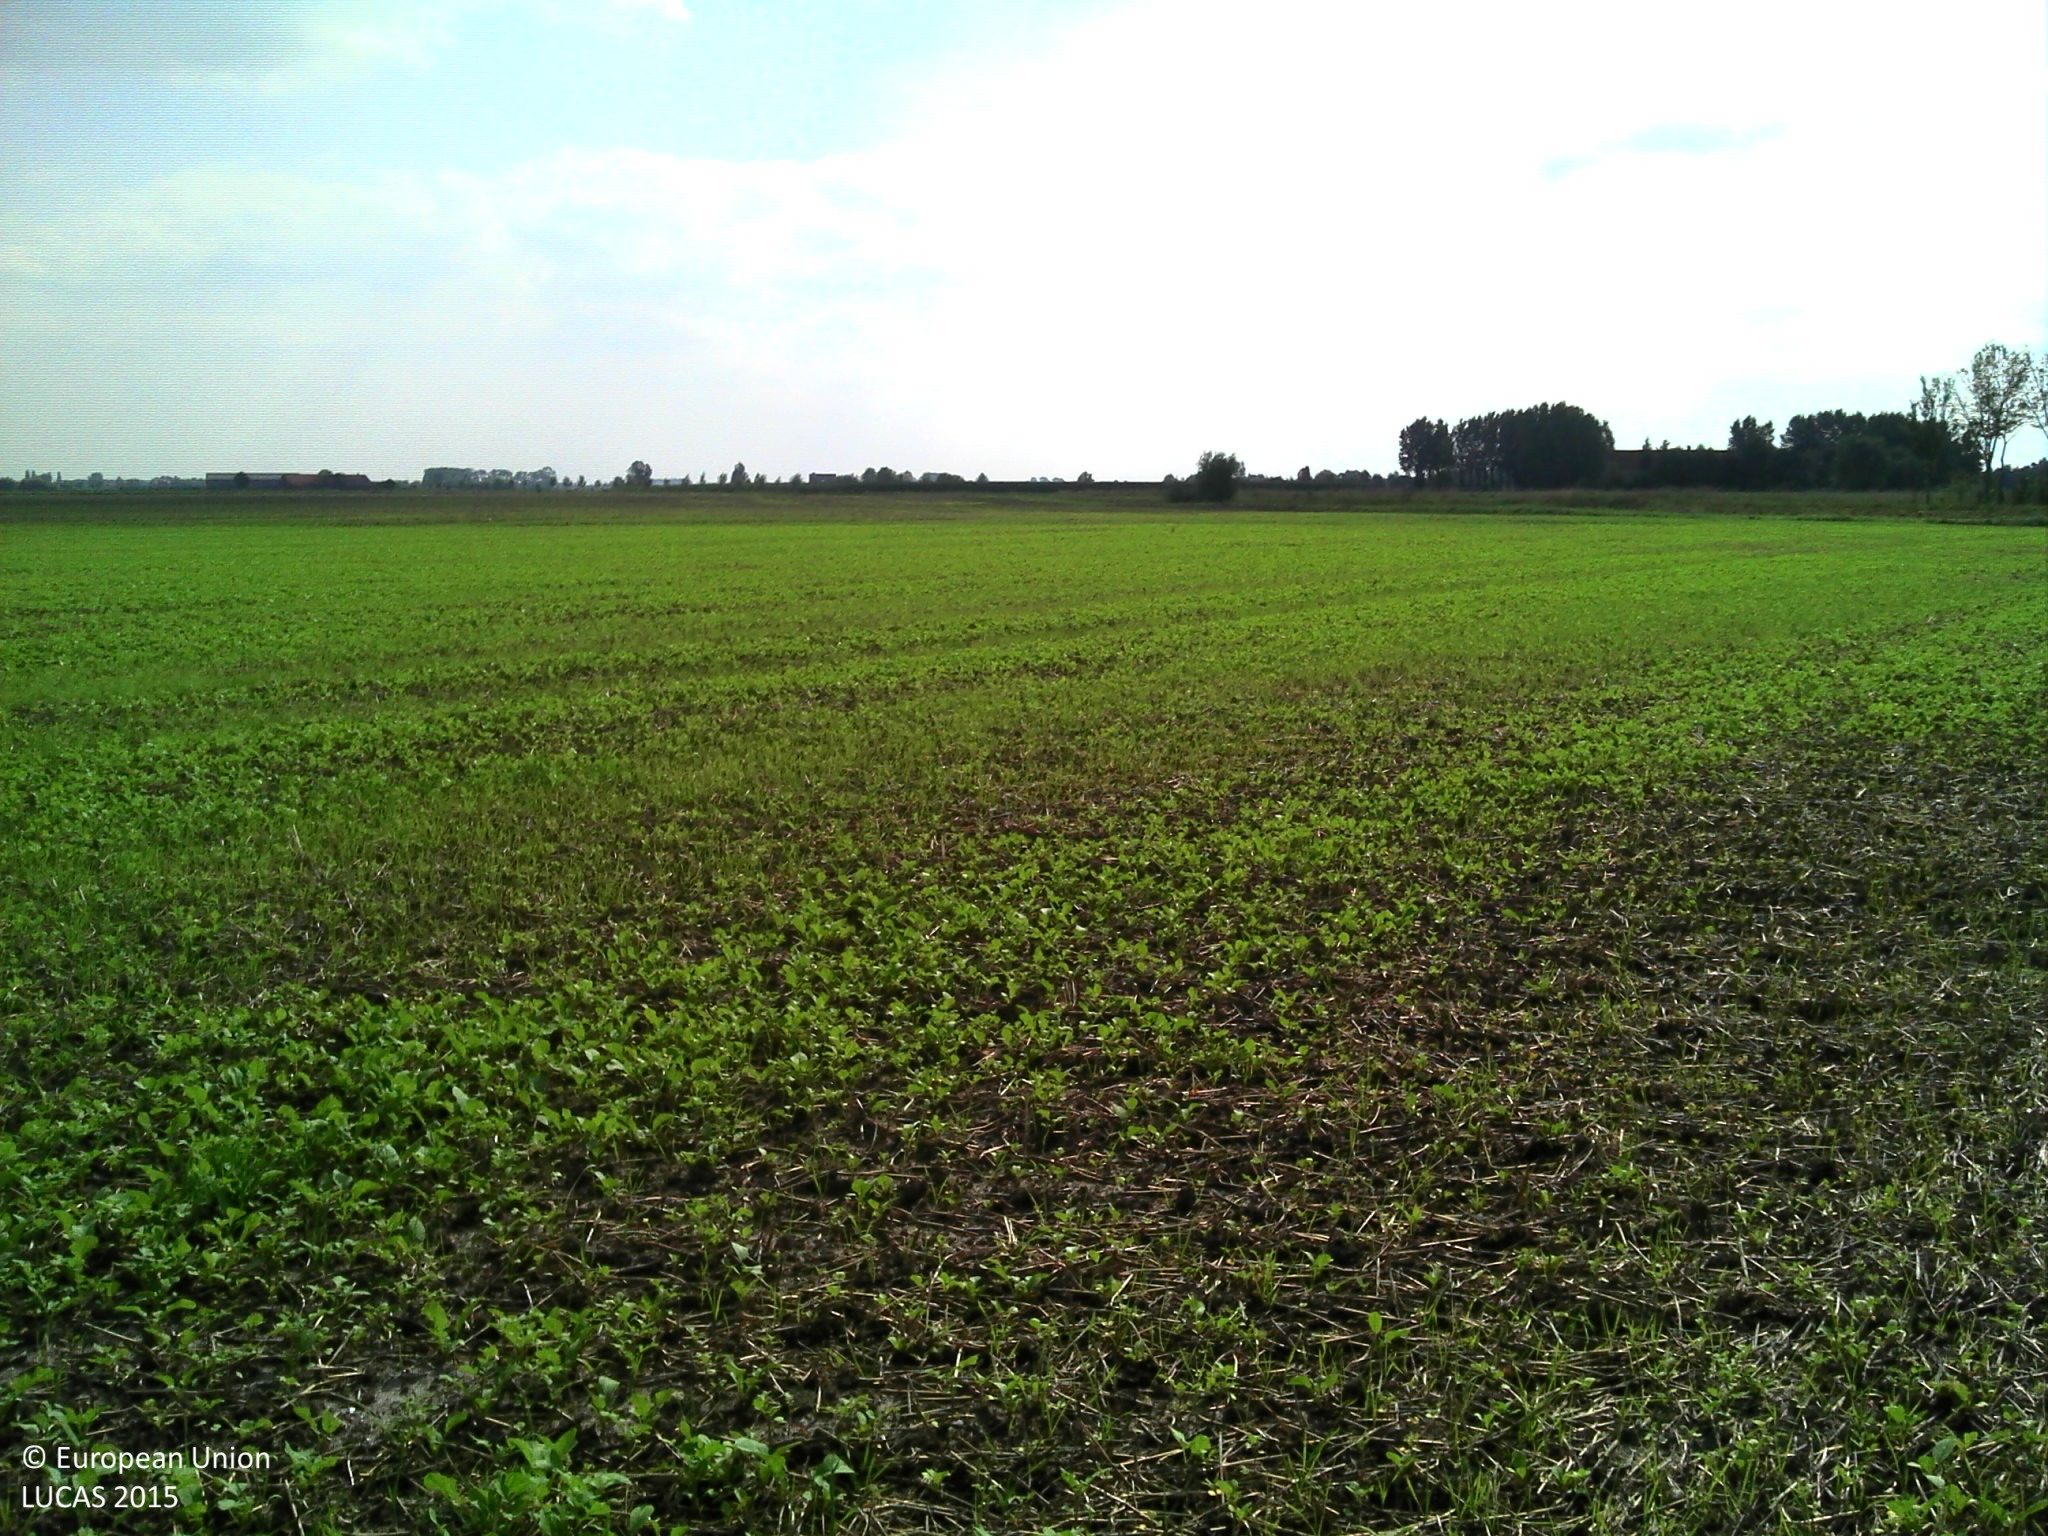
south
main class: Cropland
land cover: Common wheat
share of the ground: 25 - 50 %
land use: Agriculture (excluding fallow land and kitchen gardens)
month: September
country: BE
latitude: 51.0692
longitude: 2.6958
